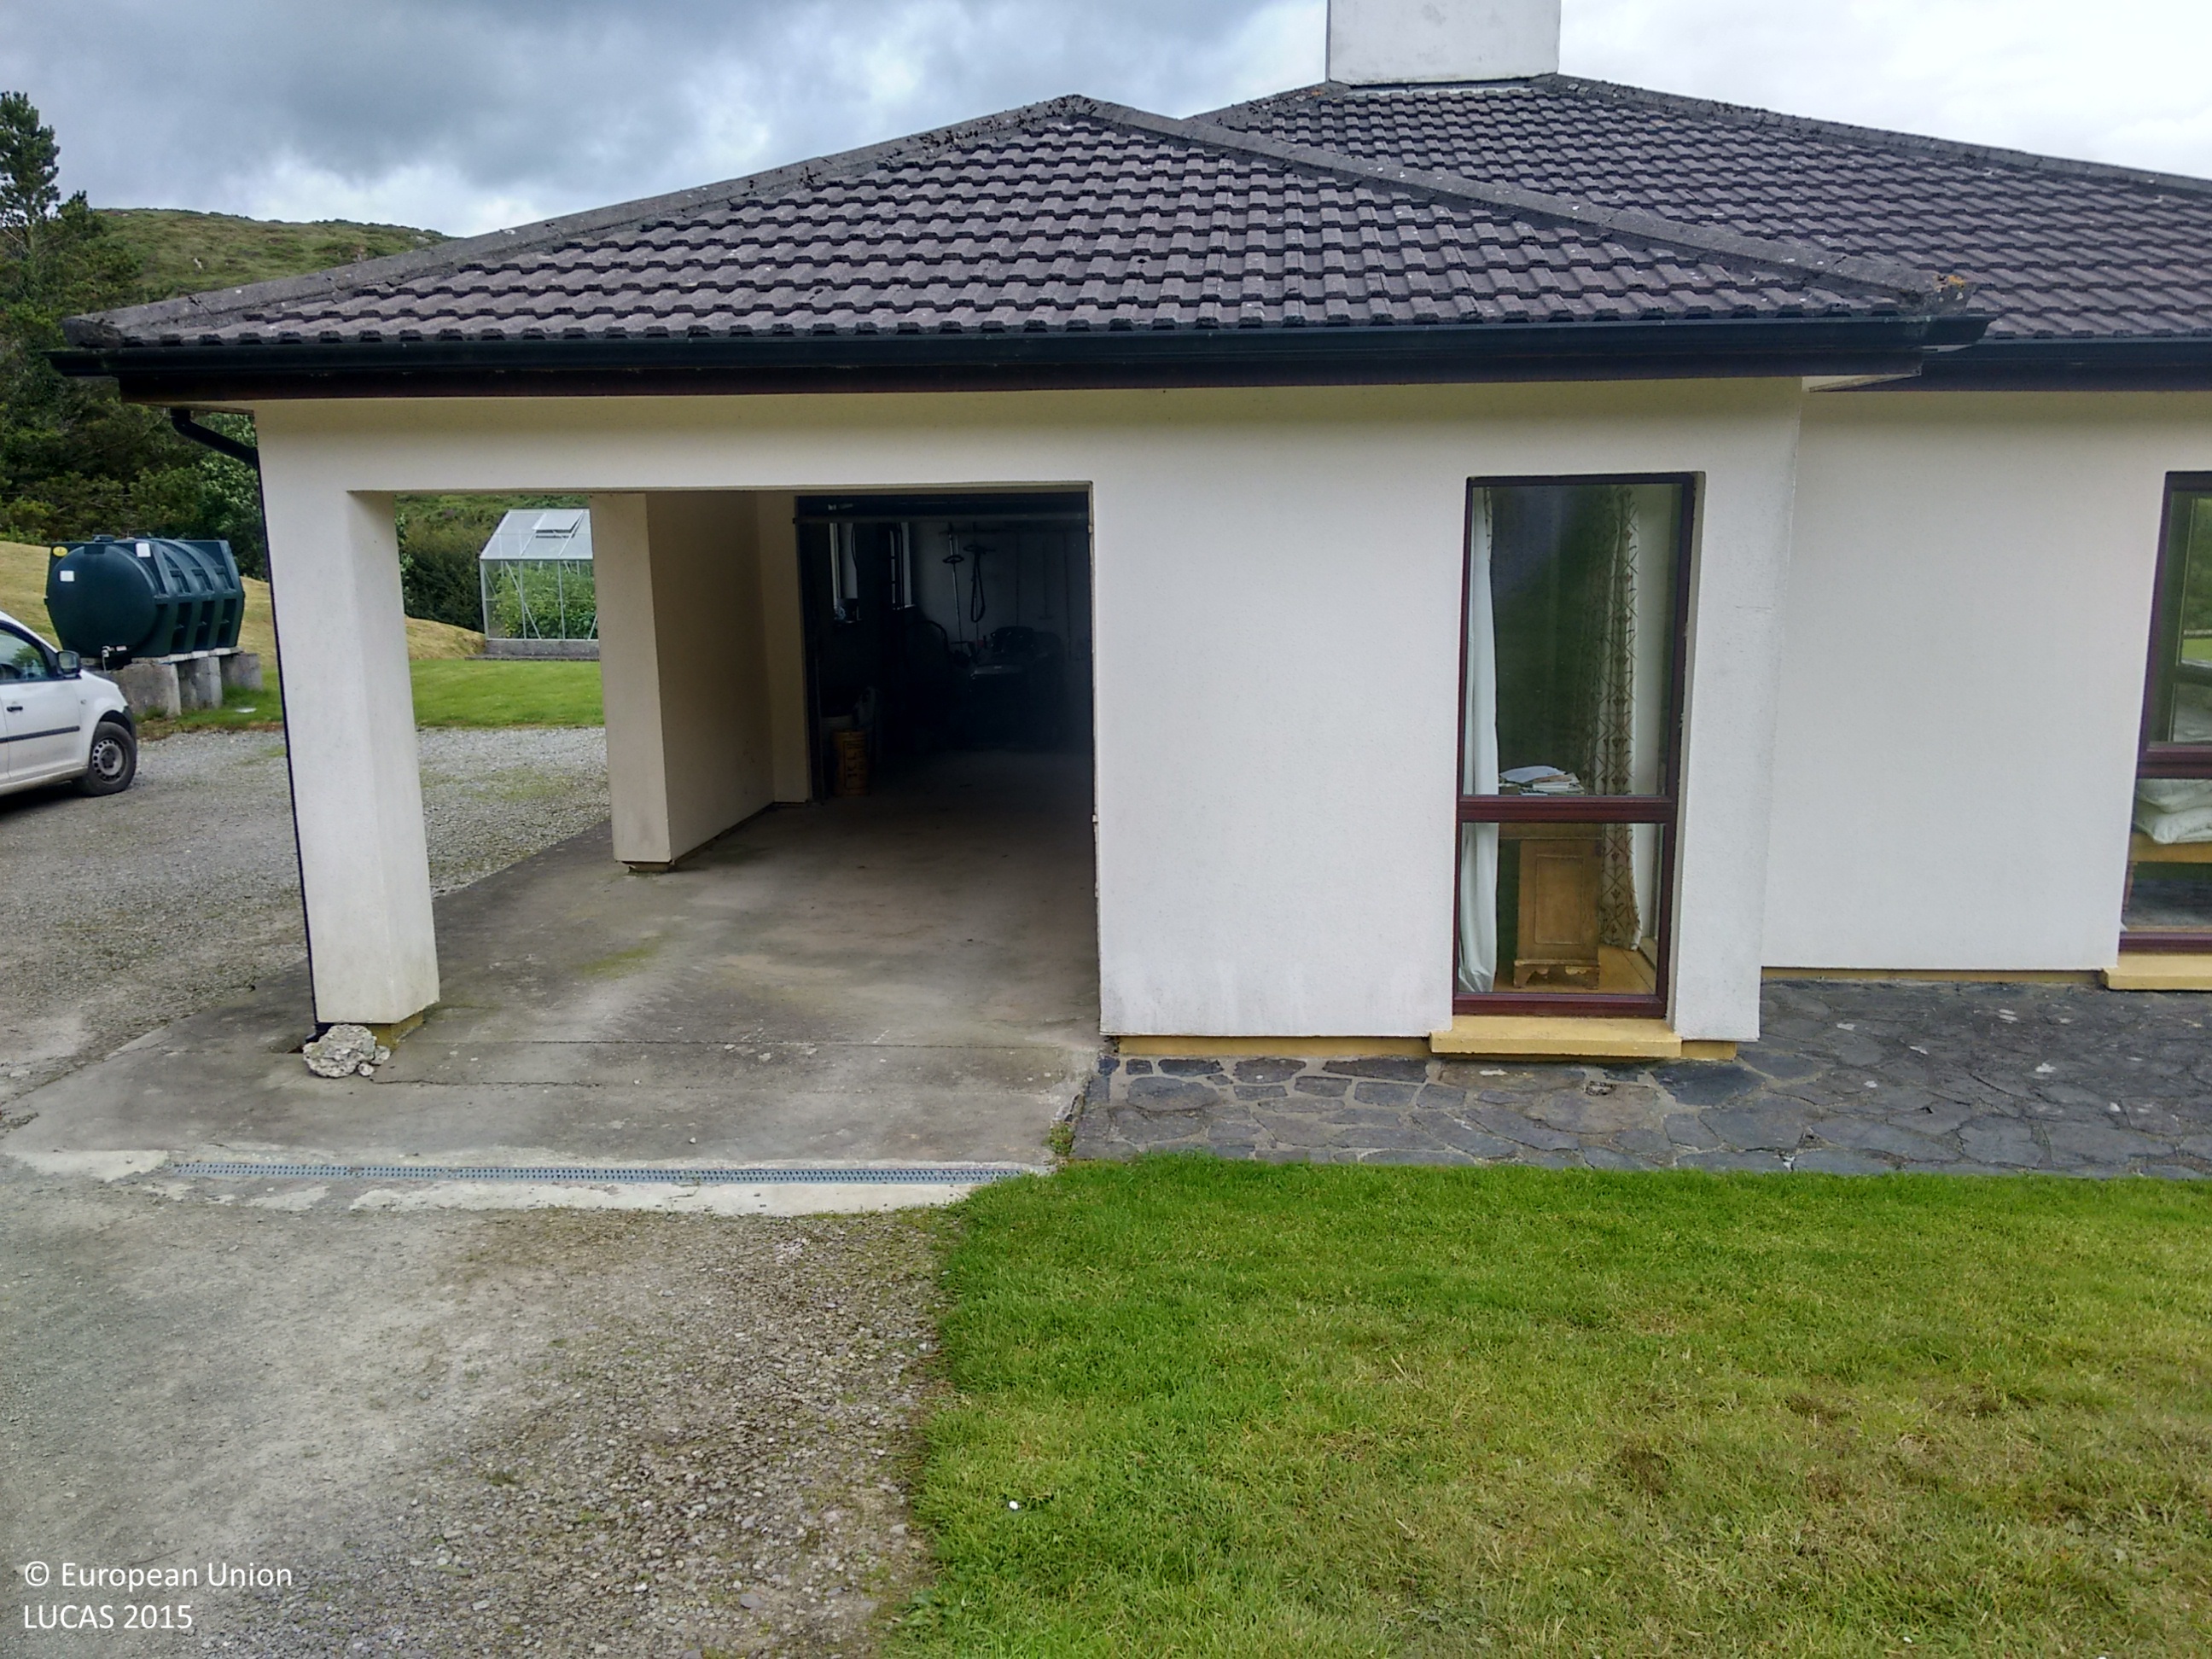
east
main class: Grassland
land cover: Grassland without tree/shrub cover
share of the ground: > 75 %
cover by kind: herbaceous plants 80 %
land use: Residential
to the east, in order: Grassland without tree/shrub cover; Fences; Transitional water bodies; Broadleaved woodland; Grassland without tree/shrub cover; Abandoned hedges; Grassland without tree/shrub cover
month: July
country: IE
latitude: 51.5510
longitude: -9.3947
